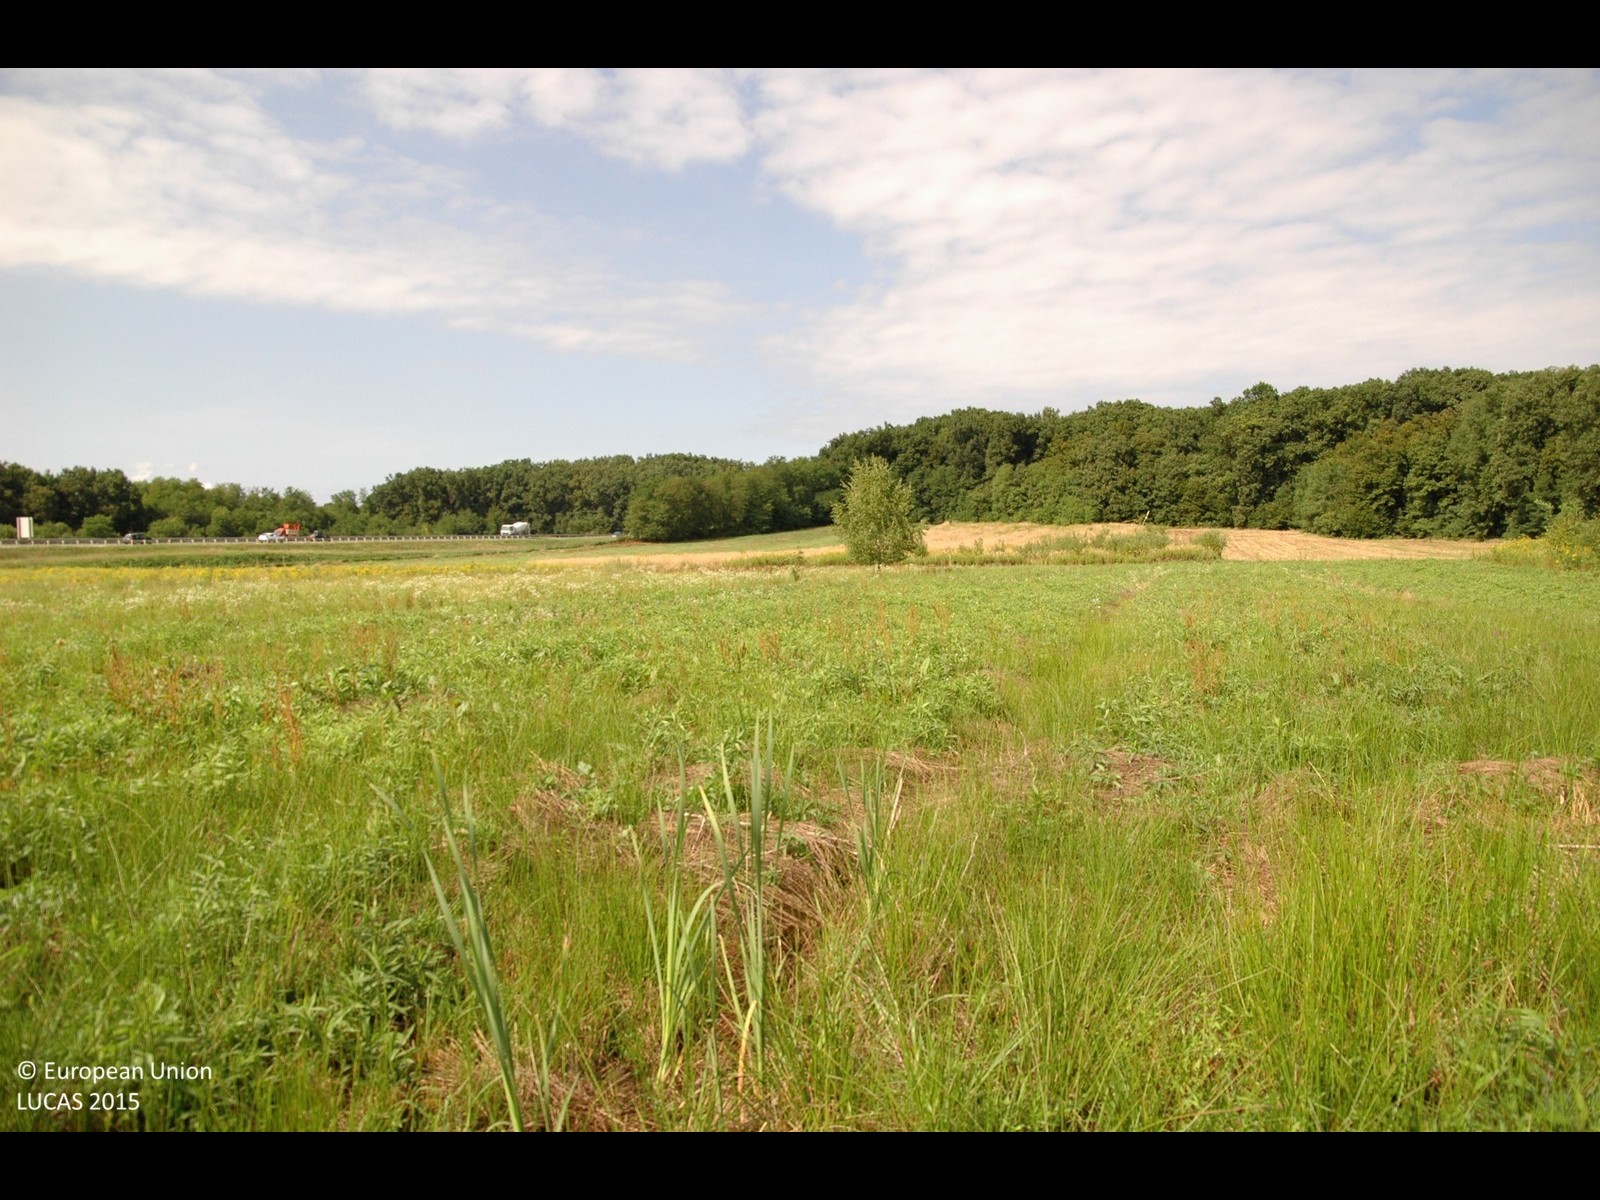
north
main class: Grassland
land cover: Grassland without tree/shrub cover
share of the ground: > 75 %
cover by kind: herbaceous plants 100 %
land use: Agriculture (excluding fallow land and kitchen gardens)
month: August
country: HR
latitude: 45.8317
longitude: 16.1389
